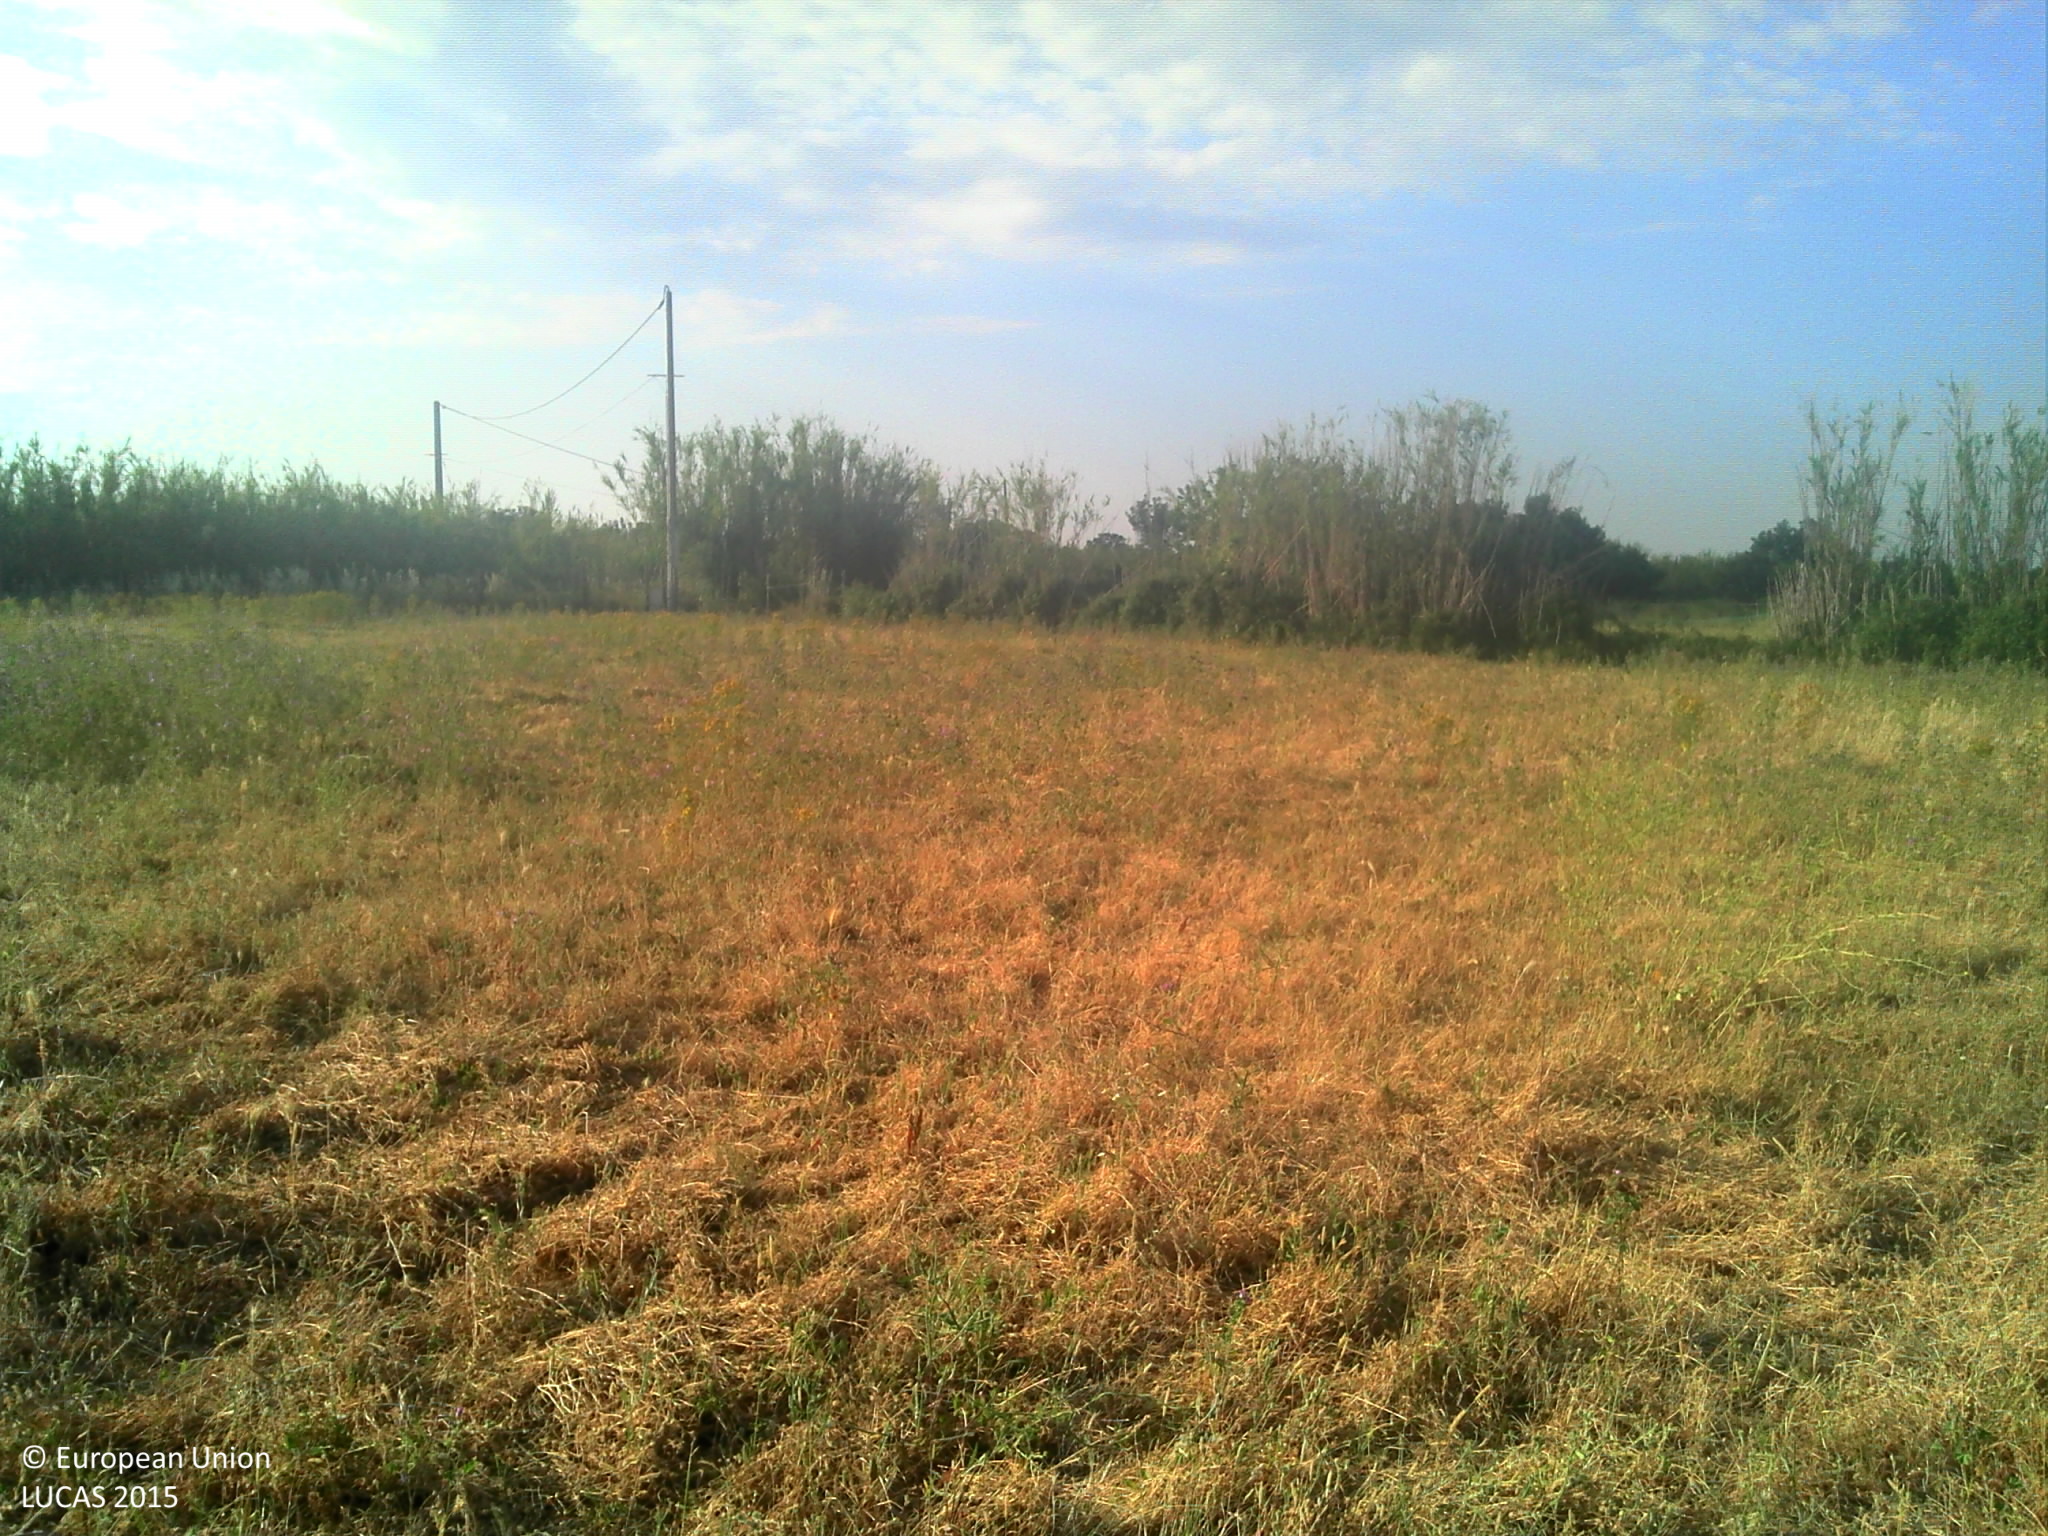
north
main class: Grassland
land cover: Grassland without tree/shrub cover
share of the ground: > 75 %
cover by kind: herbaceous plants 100 %
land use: Agriculture (excluding fallow land and kitchen gardens)
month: June
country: FR
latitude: 42.5506
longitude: 2.9127
